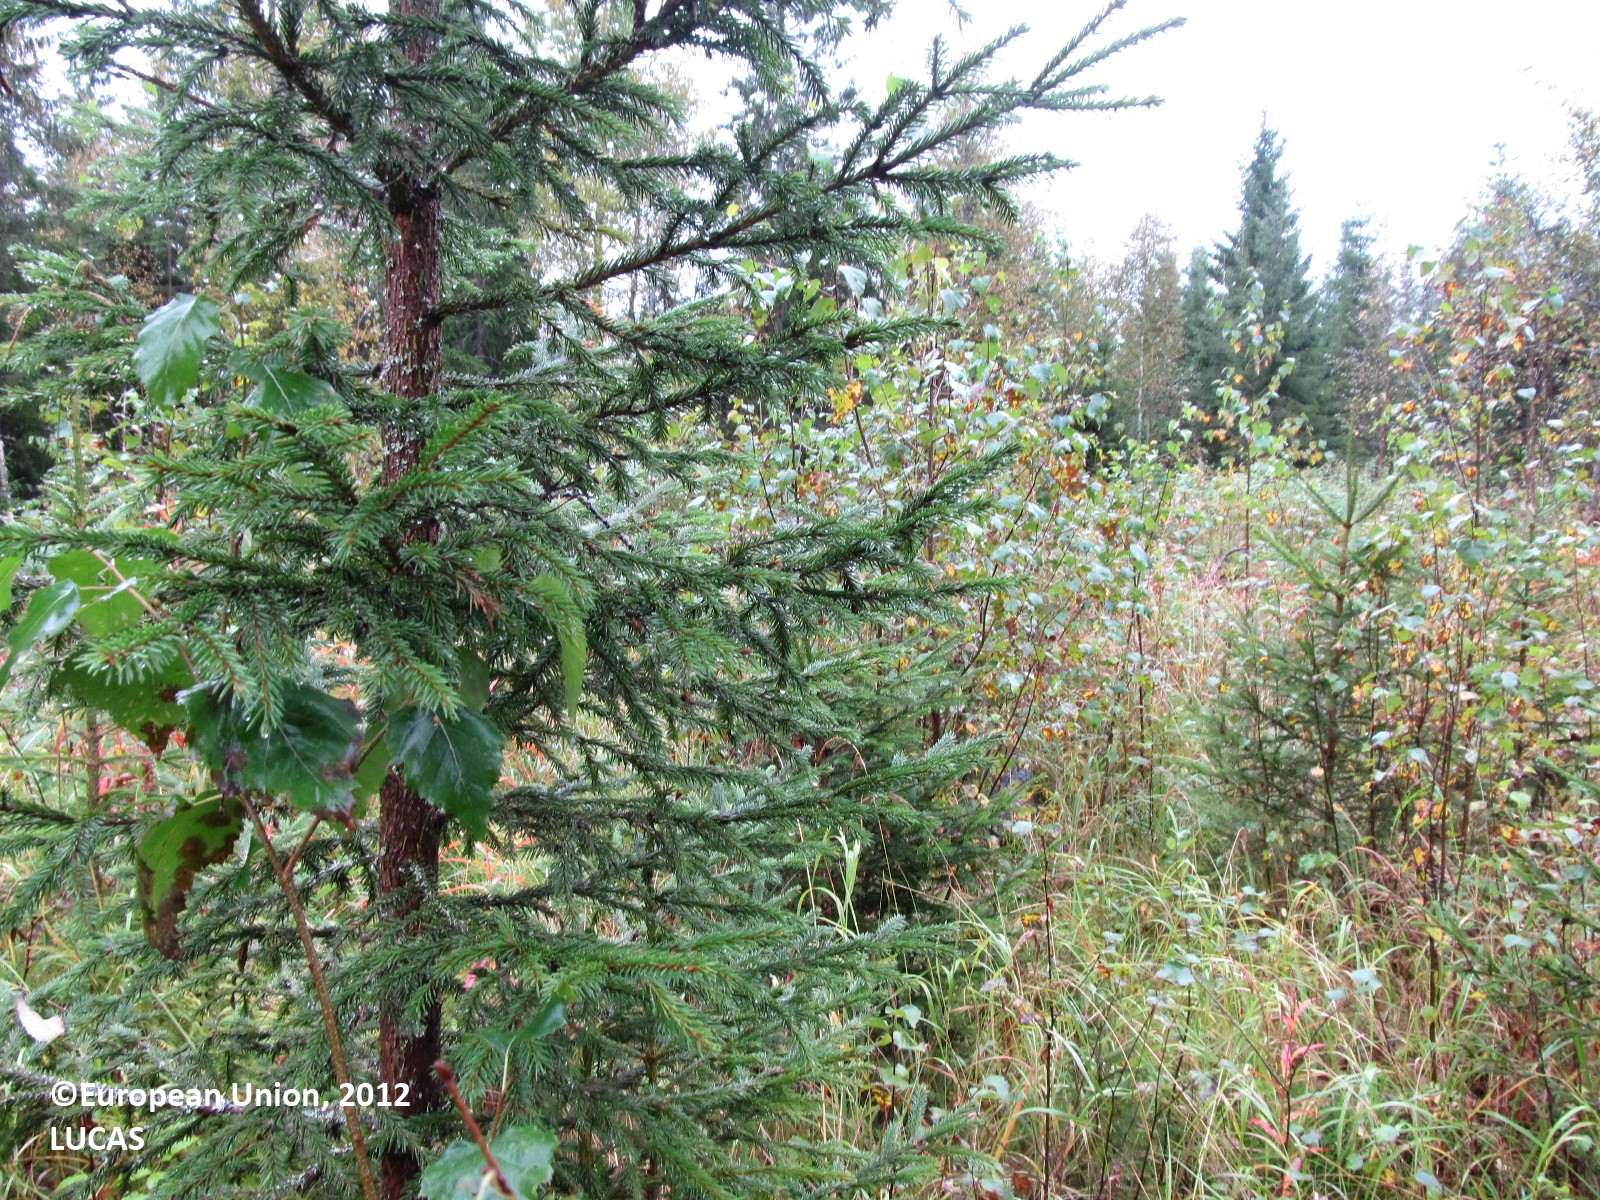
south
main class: Woodland
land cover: Spruce dominated mixed woodland
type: boreal forest
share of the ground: 25 - 50 %
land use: Forestry
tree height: < 5 m
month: September
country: FI
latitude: 63.2746
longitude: 27.8897
